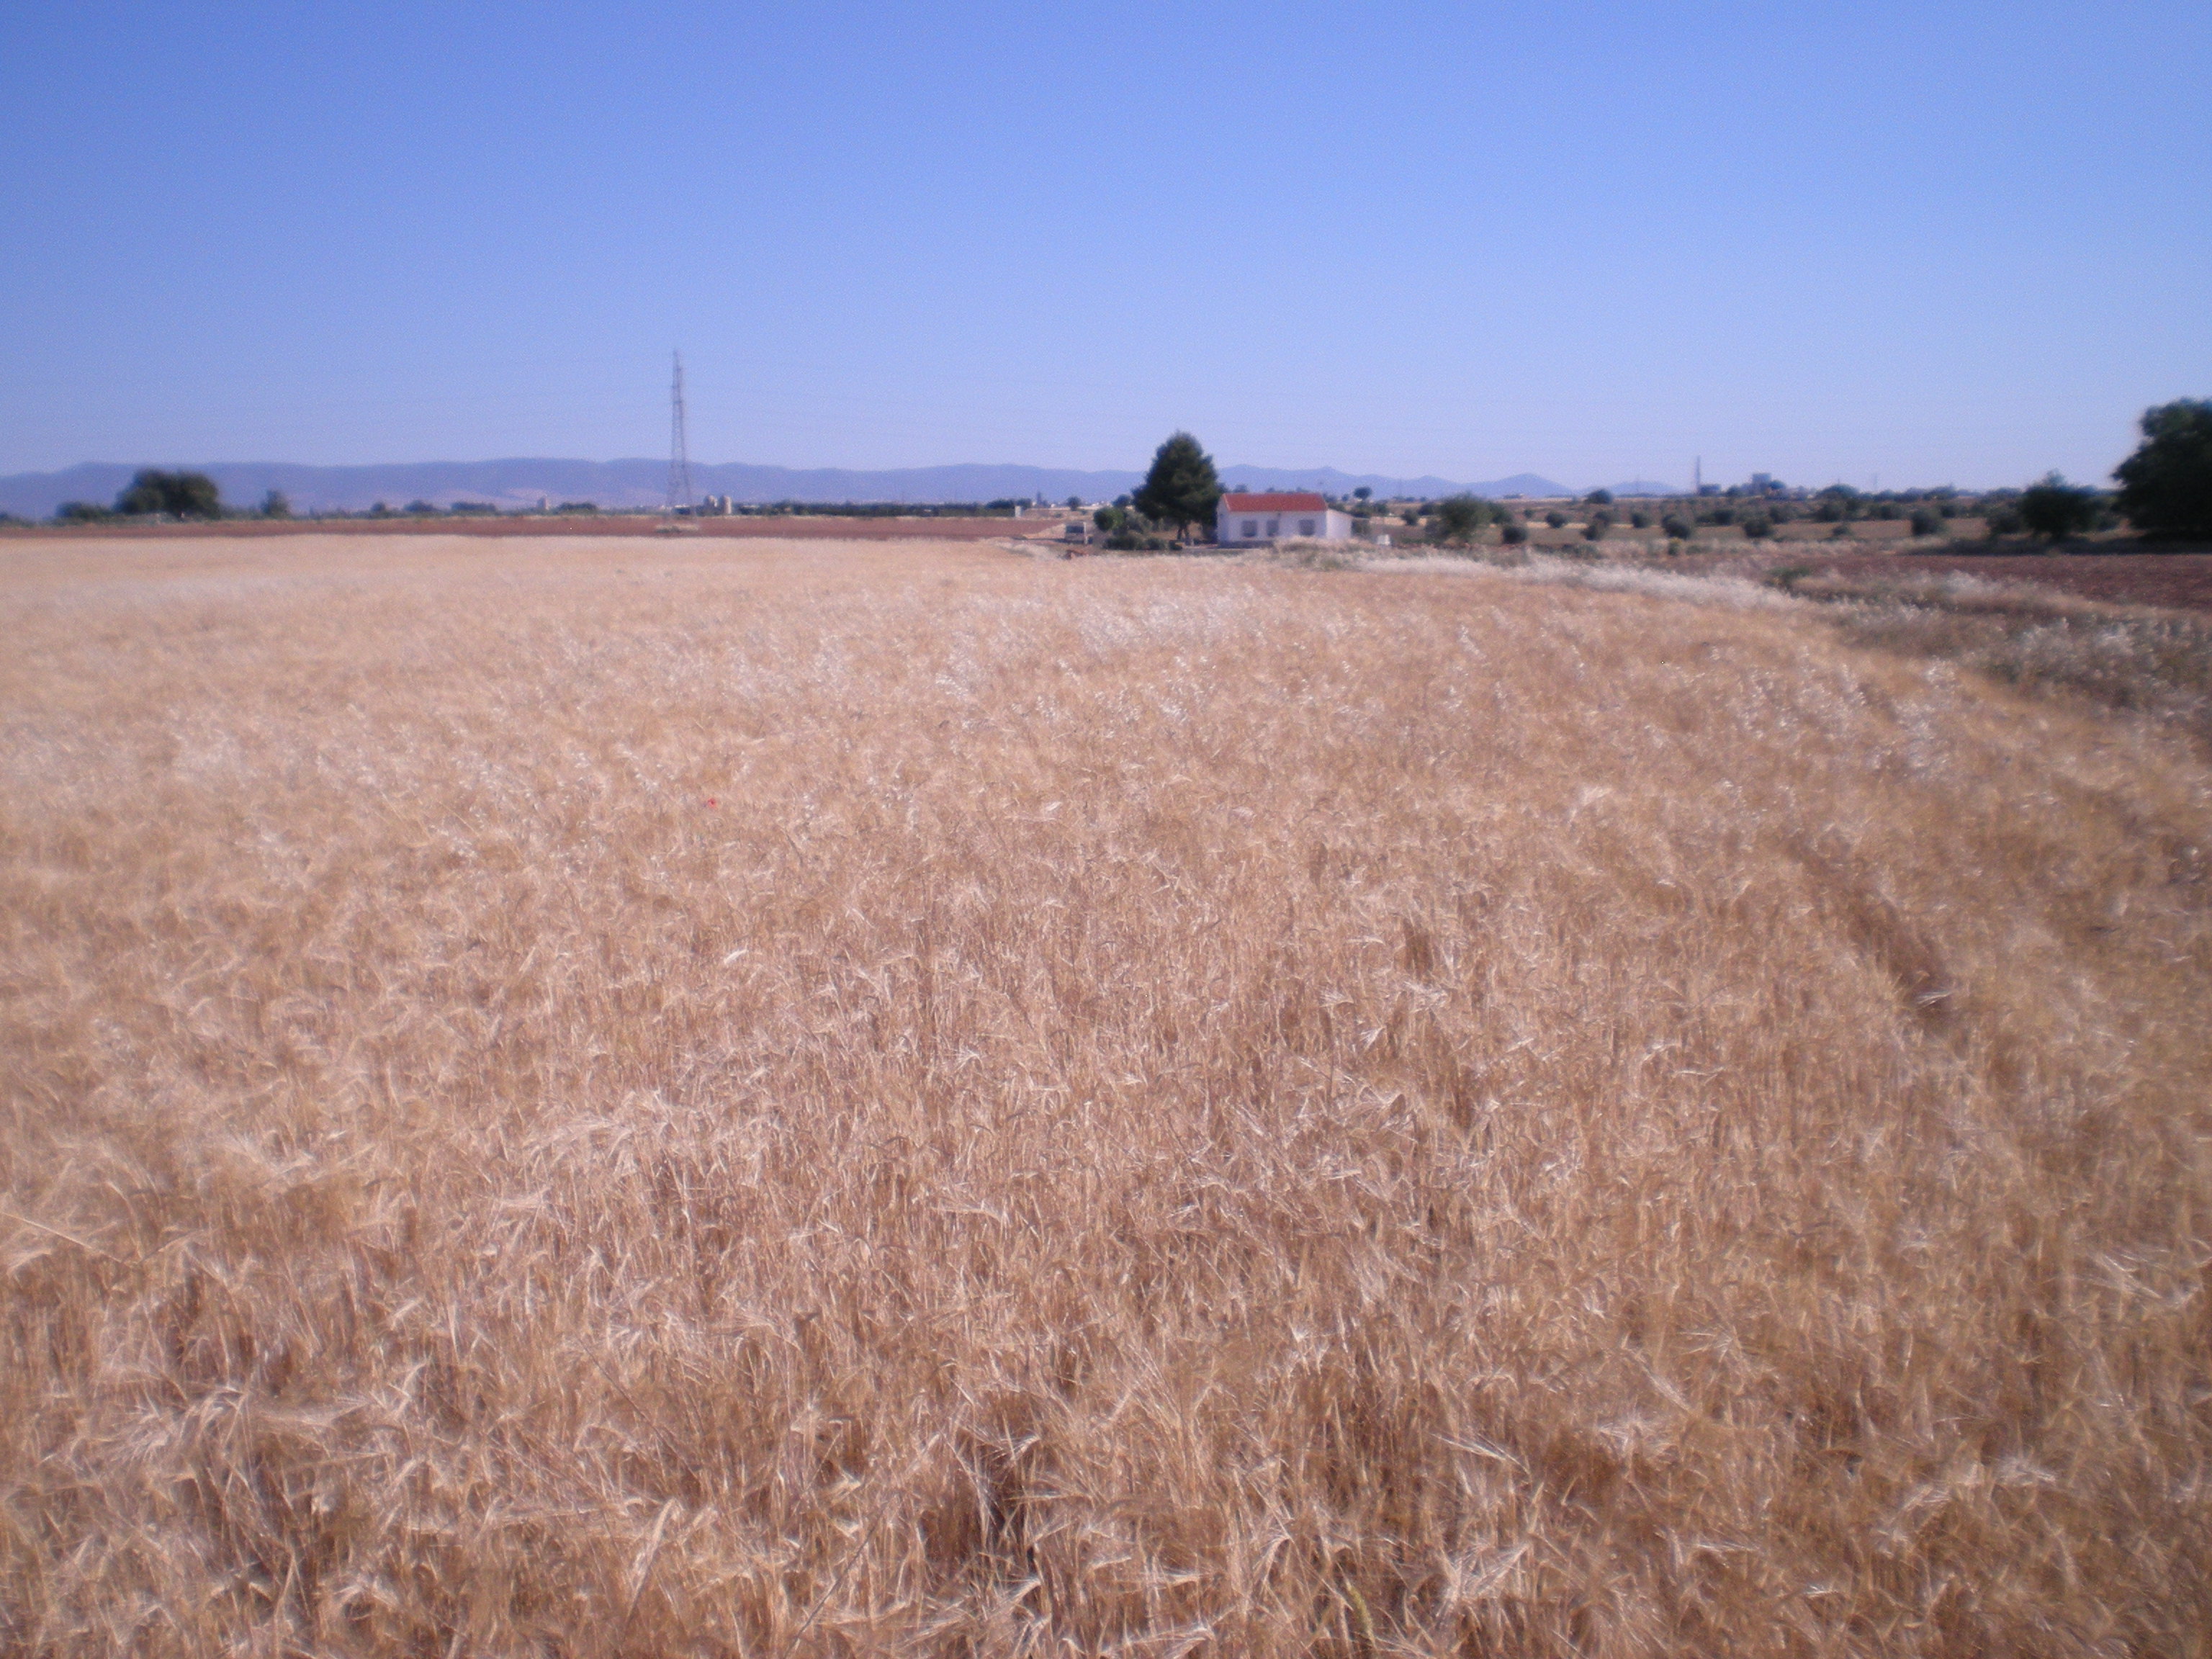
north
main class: Cropland
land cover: Barley
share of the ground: > 75 %
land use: Agriculture (excluding fallow land and kitchen gardens)
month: May
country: ES
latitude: 39.0384
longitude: -3.6153
